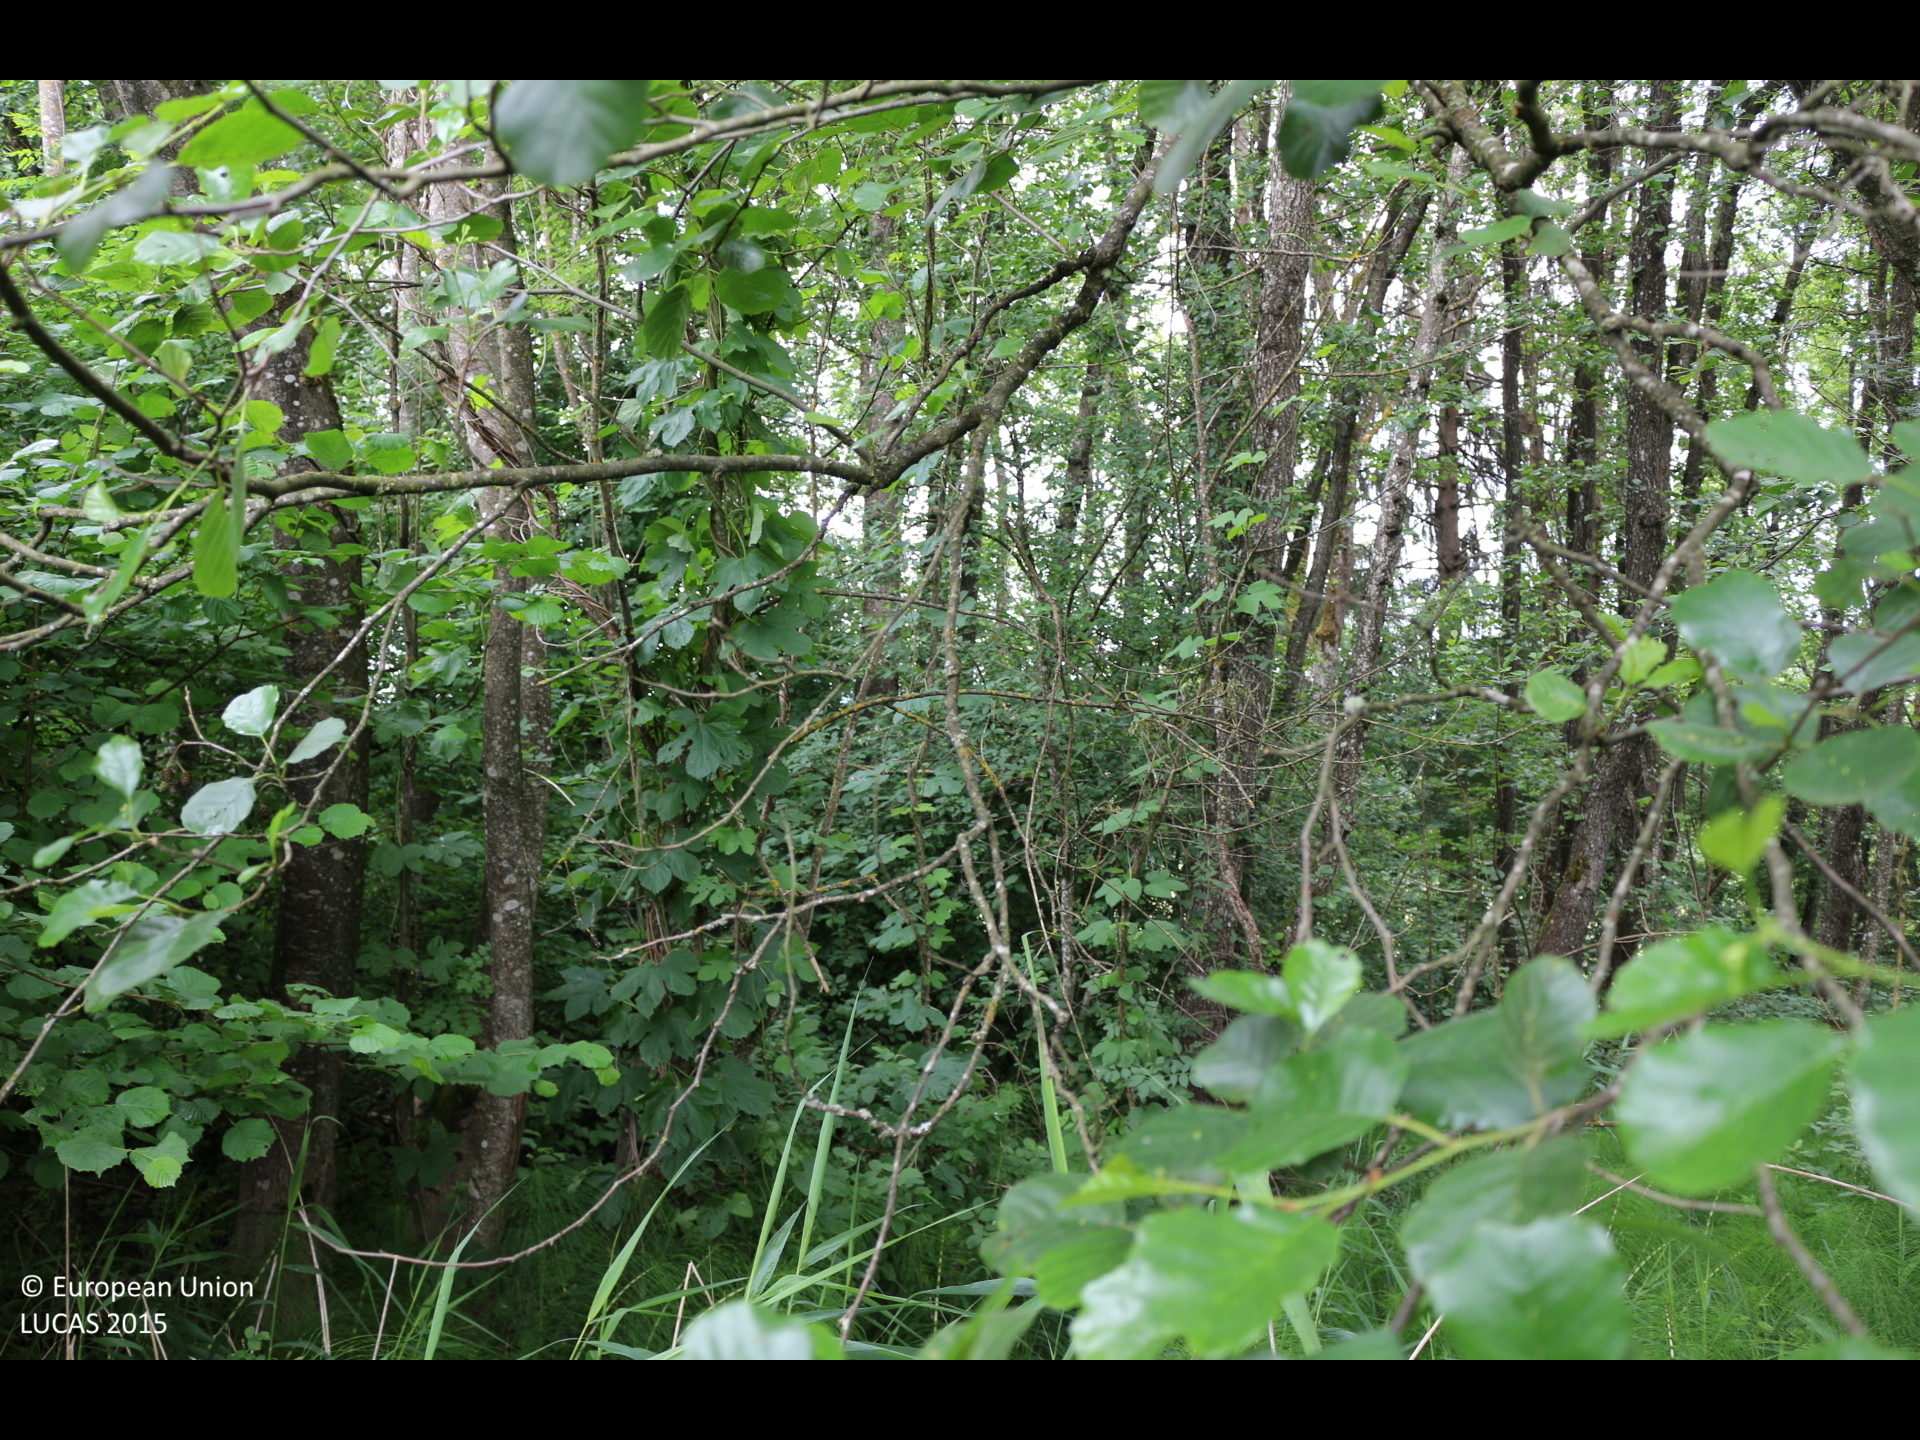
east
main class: Woodland
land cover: Broadleaved woodland
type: floodplain forest
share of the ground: > 75 %
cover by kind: broadleaved forest trees 100 %
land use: Forestry
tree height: > 5 m
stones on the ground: 10 - 25 %
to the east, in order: Broadleaved woodland; Grassland without tree/shrub cover; Abandoned hedges; Grassland without tree/shrub cover
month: June
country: AT
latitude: 46.7145
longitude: 14.3277
